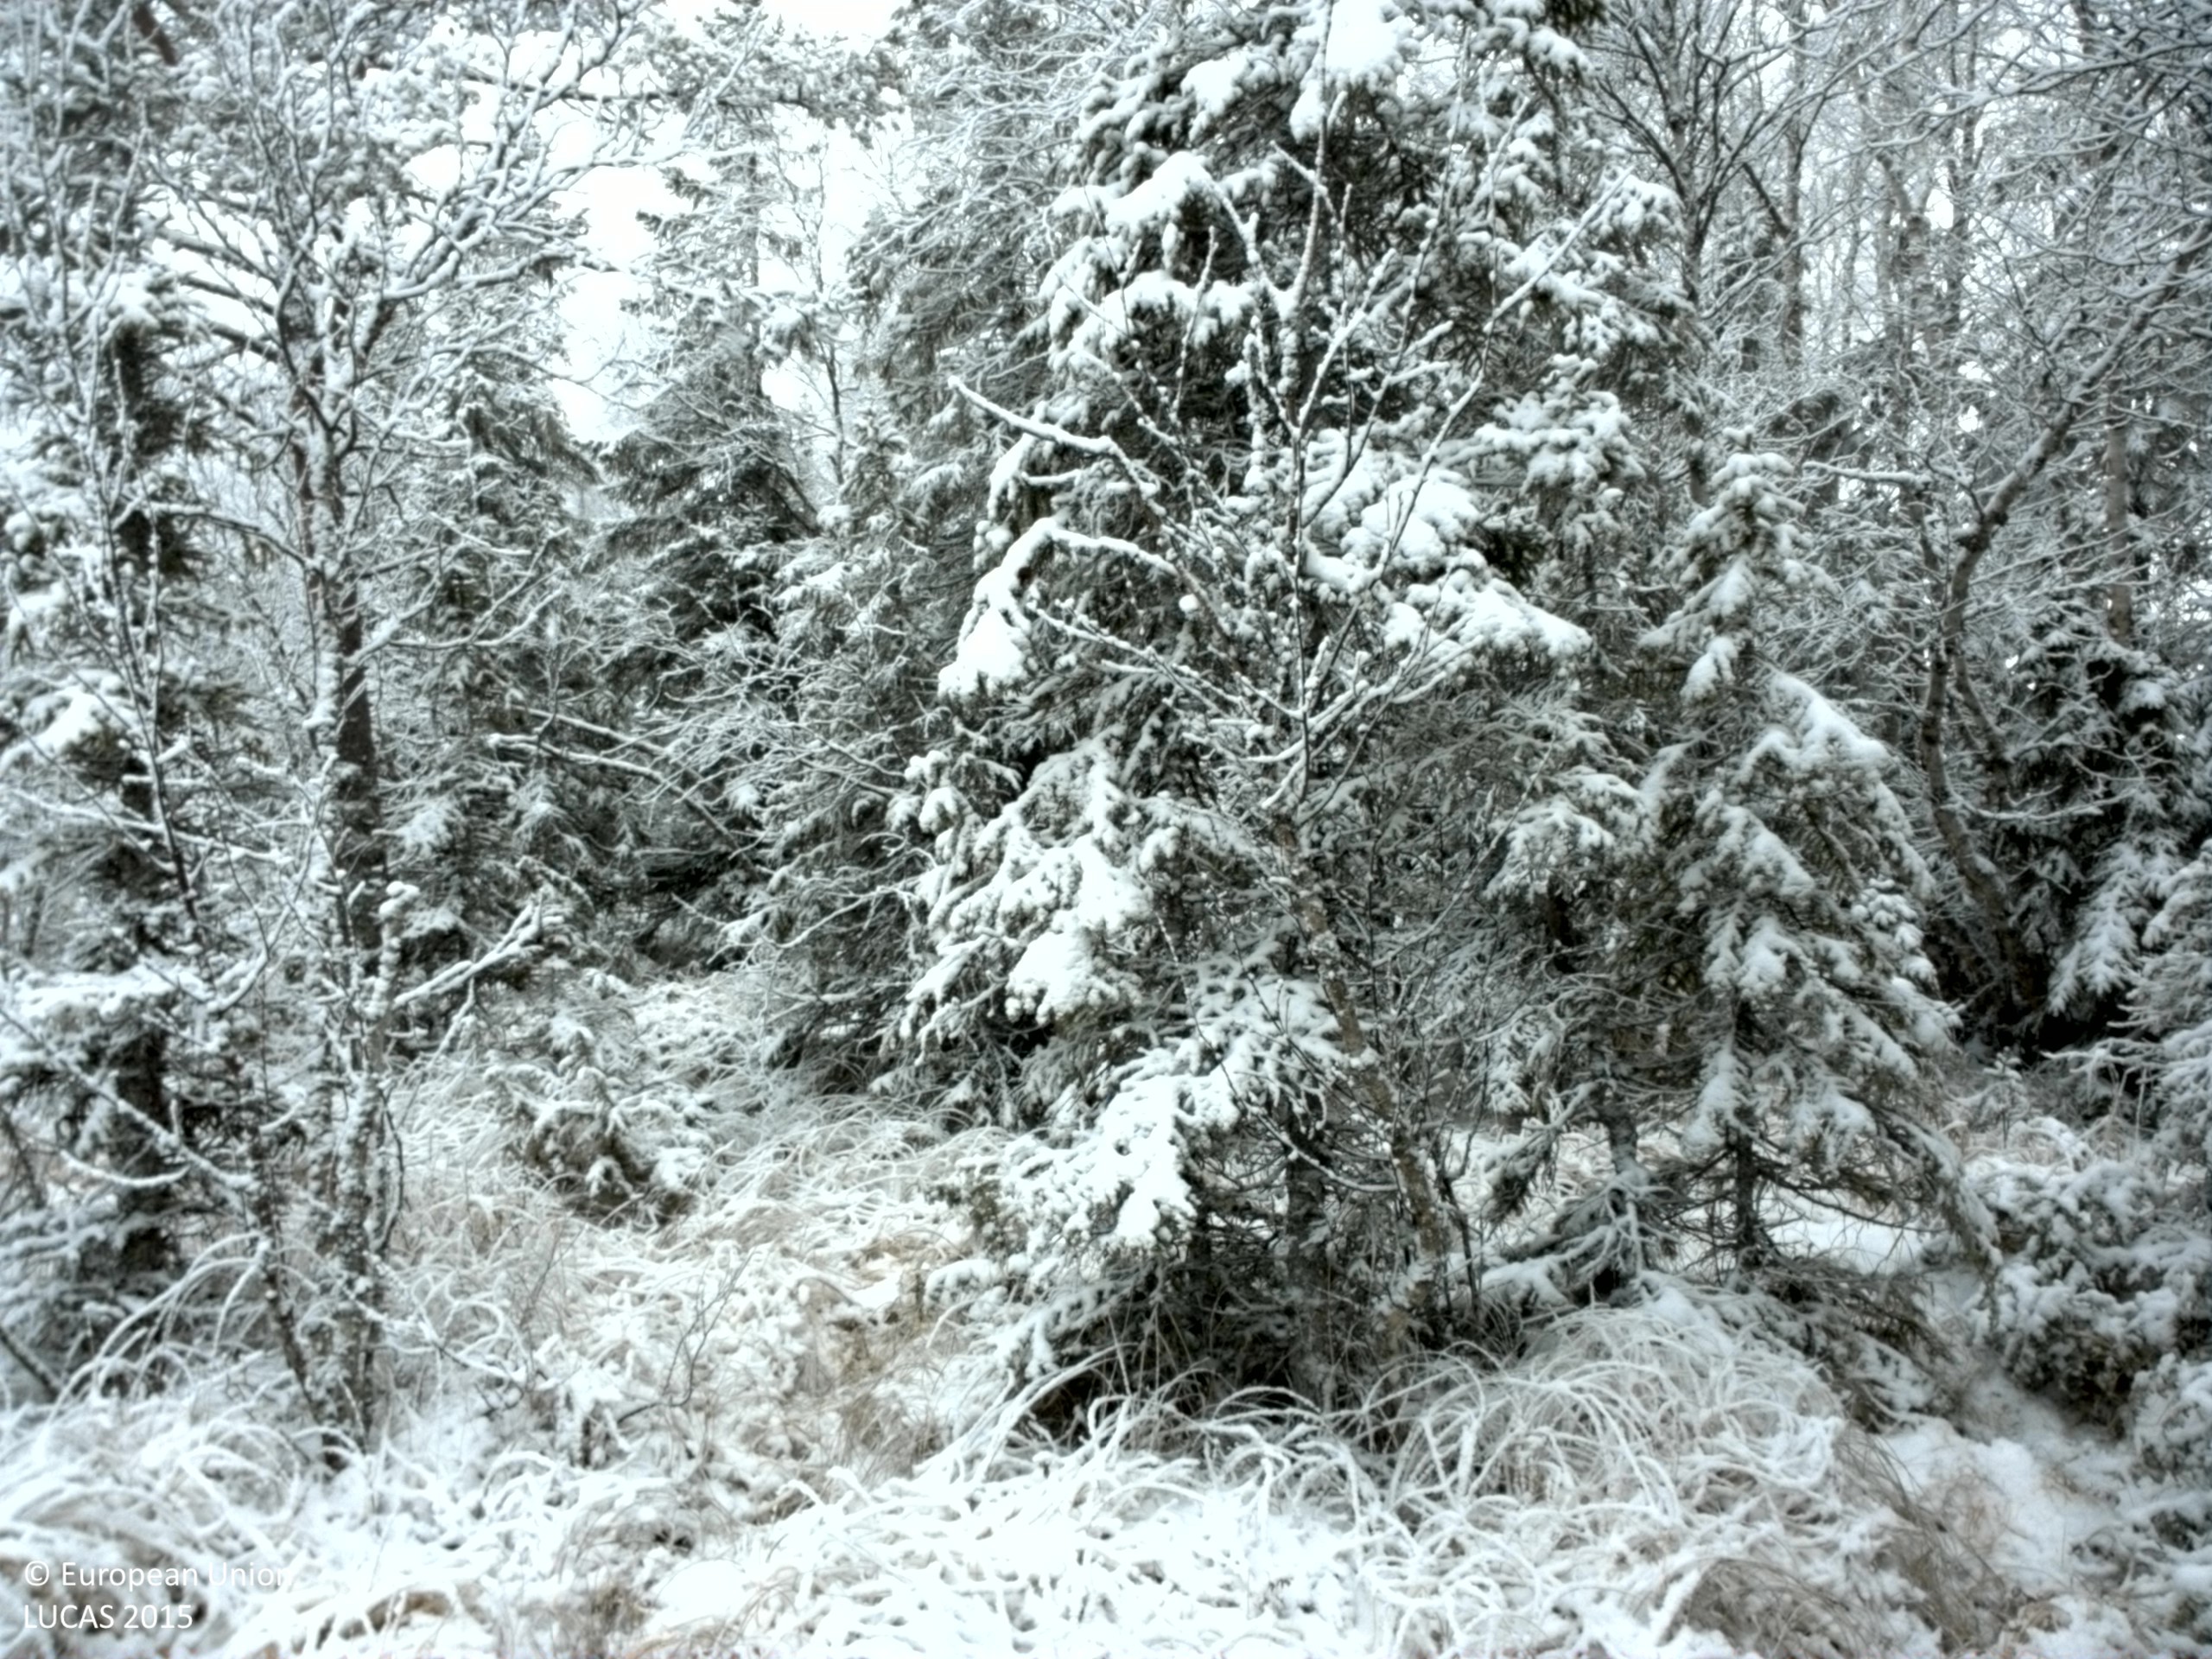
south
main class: Woodland
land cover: Spruce dominated mixed woodland
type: mire and swamp forests
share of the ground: 25 - 50 %
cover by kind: herbaceous plants 40 %, lichens and mosses 20 %, coniferous forest trees 15 %, shrubs 15 %, broadleaved forest trees 10 %
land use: Forestry
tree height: < 5 m
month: November
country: SE
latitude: 63.7319
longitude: 15.2604
